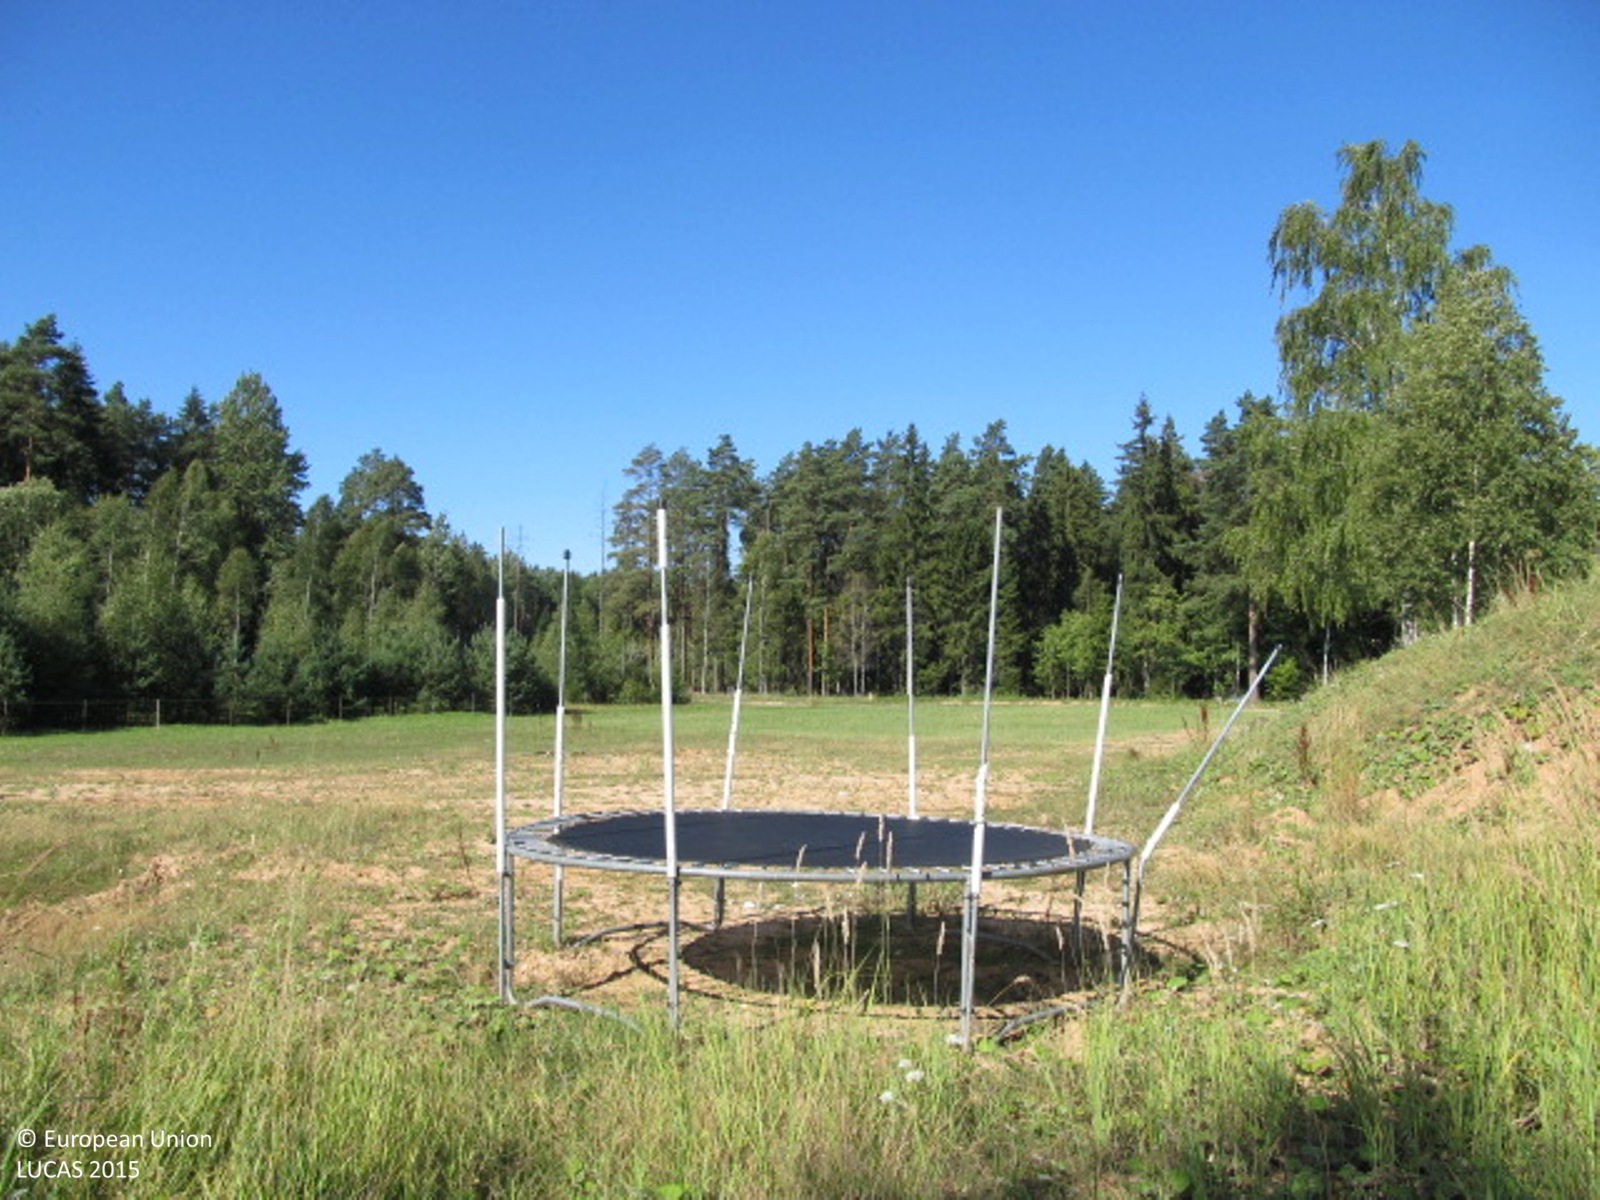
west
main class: Grassland
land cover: Spontaneously vegetated surfaces
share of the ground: 50 - 75 %
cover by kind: herbaceous plants 50 %, unconsolidated bare surface 45 %
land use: Amenities, museums, leisure
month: August
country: LT
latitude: 56.3099
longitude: 22.4226
